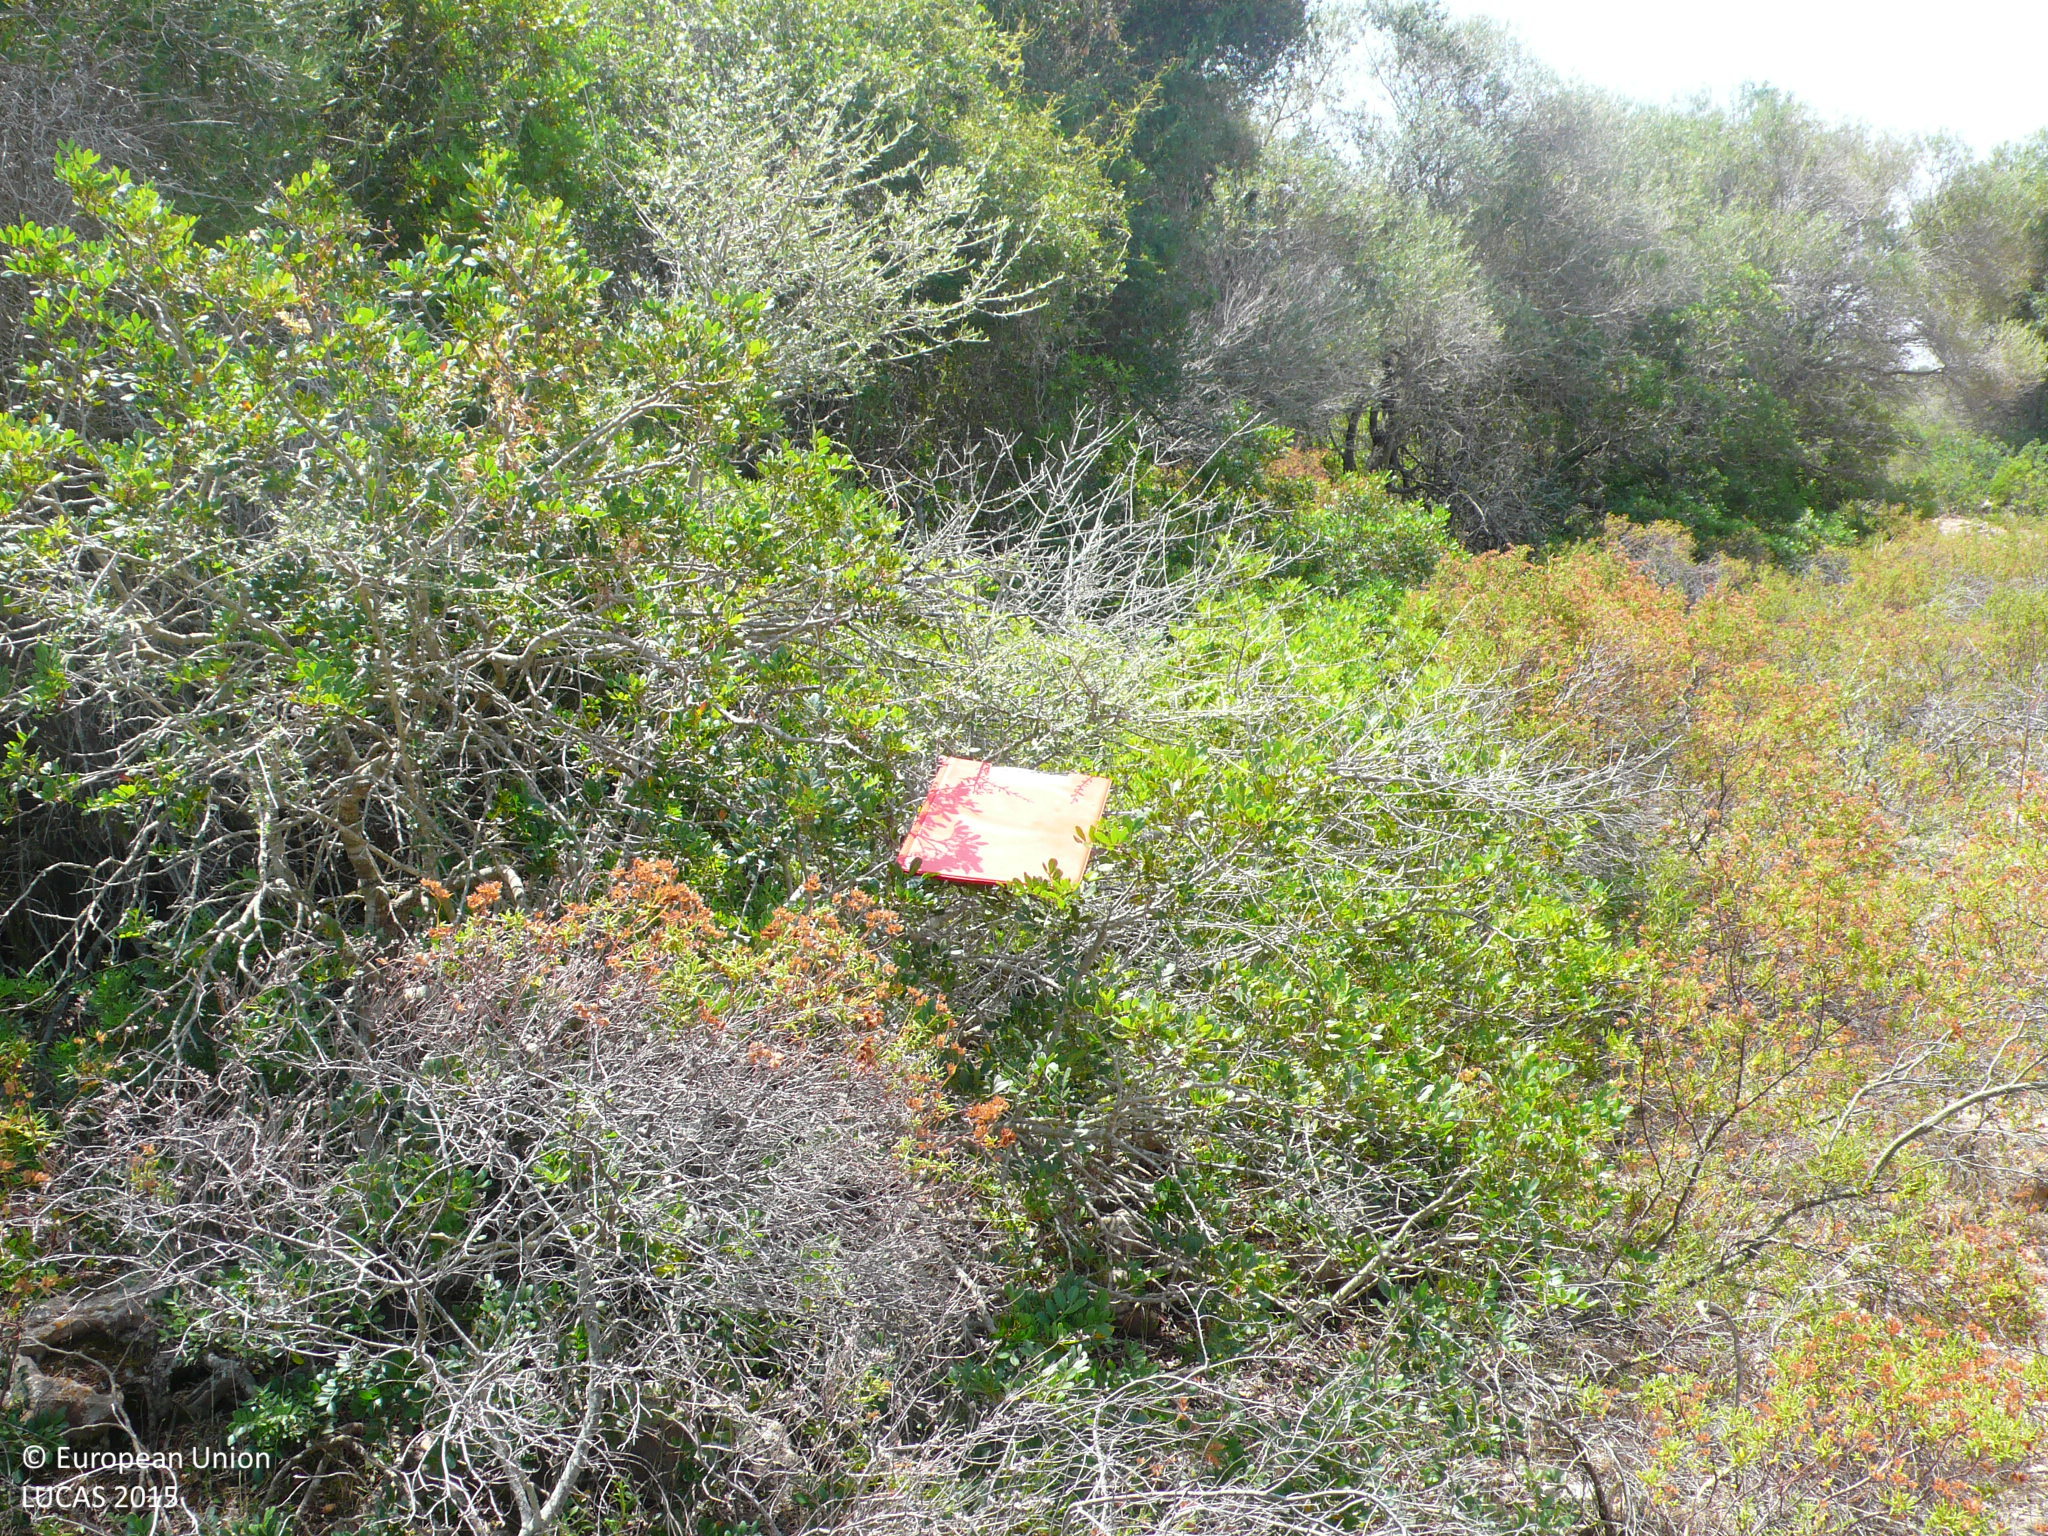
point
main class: Woodland
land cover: Broadleaved woodland
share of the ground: 50 - 75 %
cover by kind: broadleaved forest trees 50 %, shrubs 35 %, herbaceous plants 10 %, consolidated bare surface 5 %
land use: Semi-natural and natural areas not in use
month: July
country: ES
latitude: 39.6899
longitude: 3.2543
